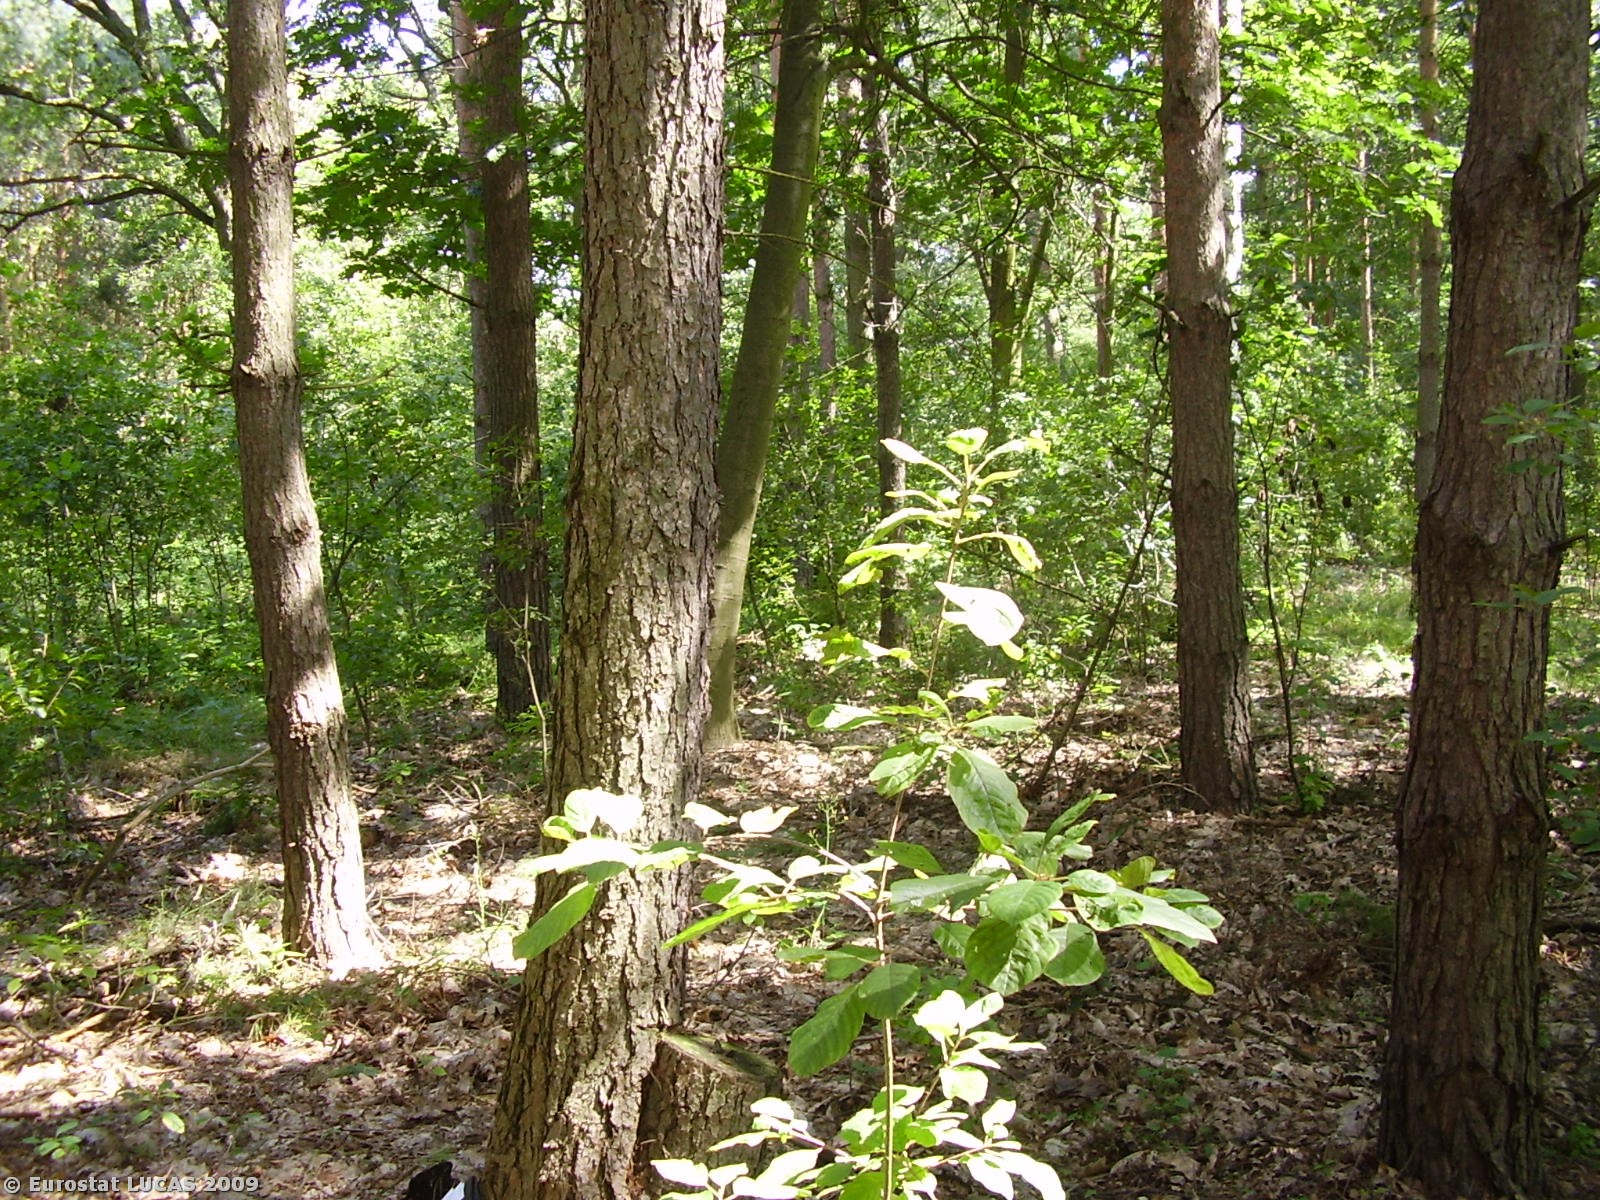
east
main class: Woodland
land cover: Mixed woodland
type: hemiboreal forest and nemoral coniferous forest and mixed broadleaved-coniferous forest
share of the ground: > 75 %
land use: Unused
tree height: > 5 m
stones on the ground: < 10 %
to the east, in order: Mixed woodland; Broadleaved woodland; Electric lines; Grass margins; Paved roads, cycling and walking lanes; Grass margins; Fences; Artificial constructions in urban areas
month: August
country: PL
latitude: 51.4837
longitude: 17.0232
